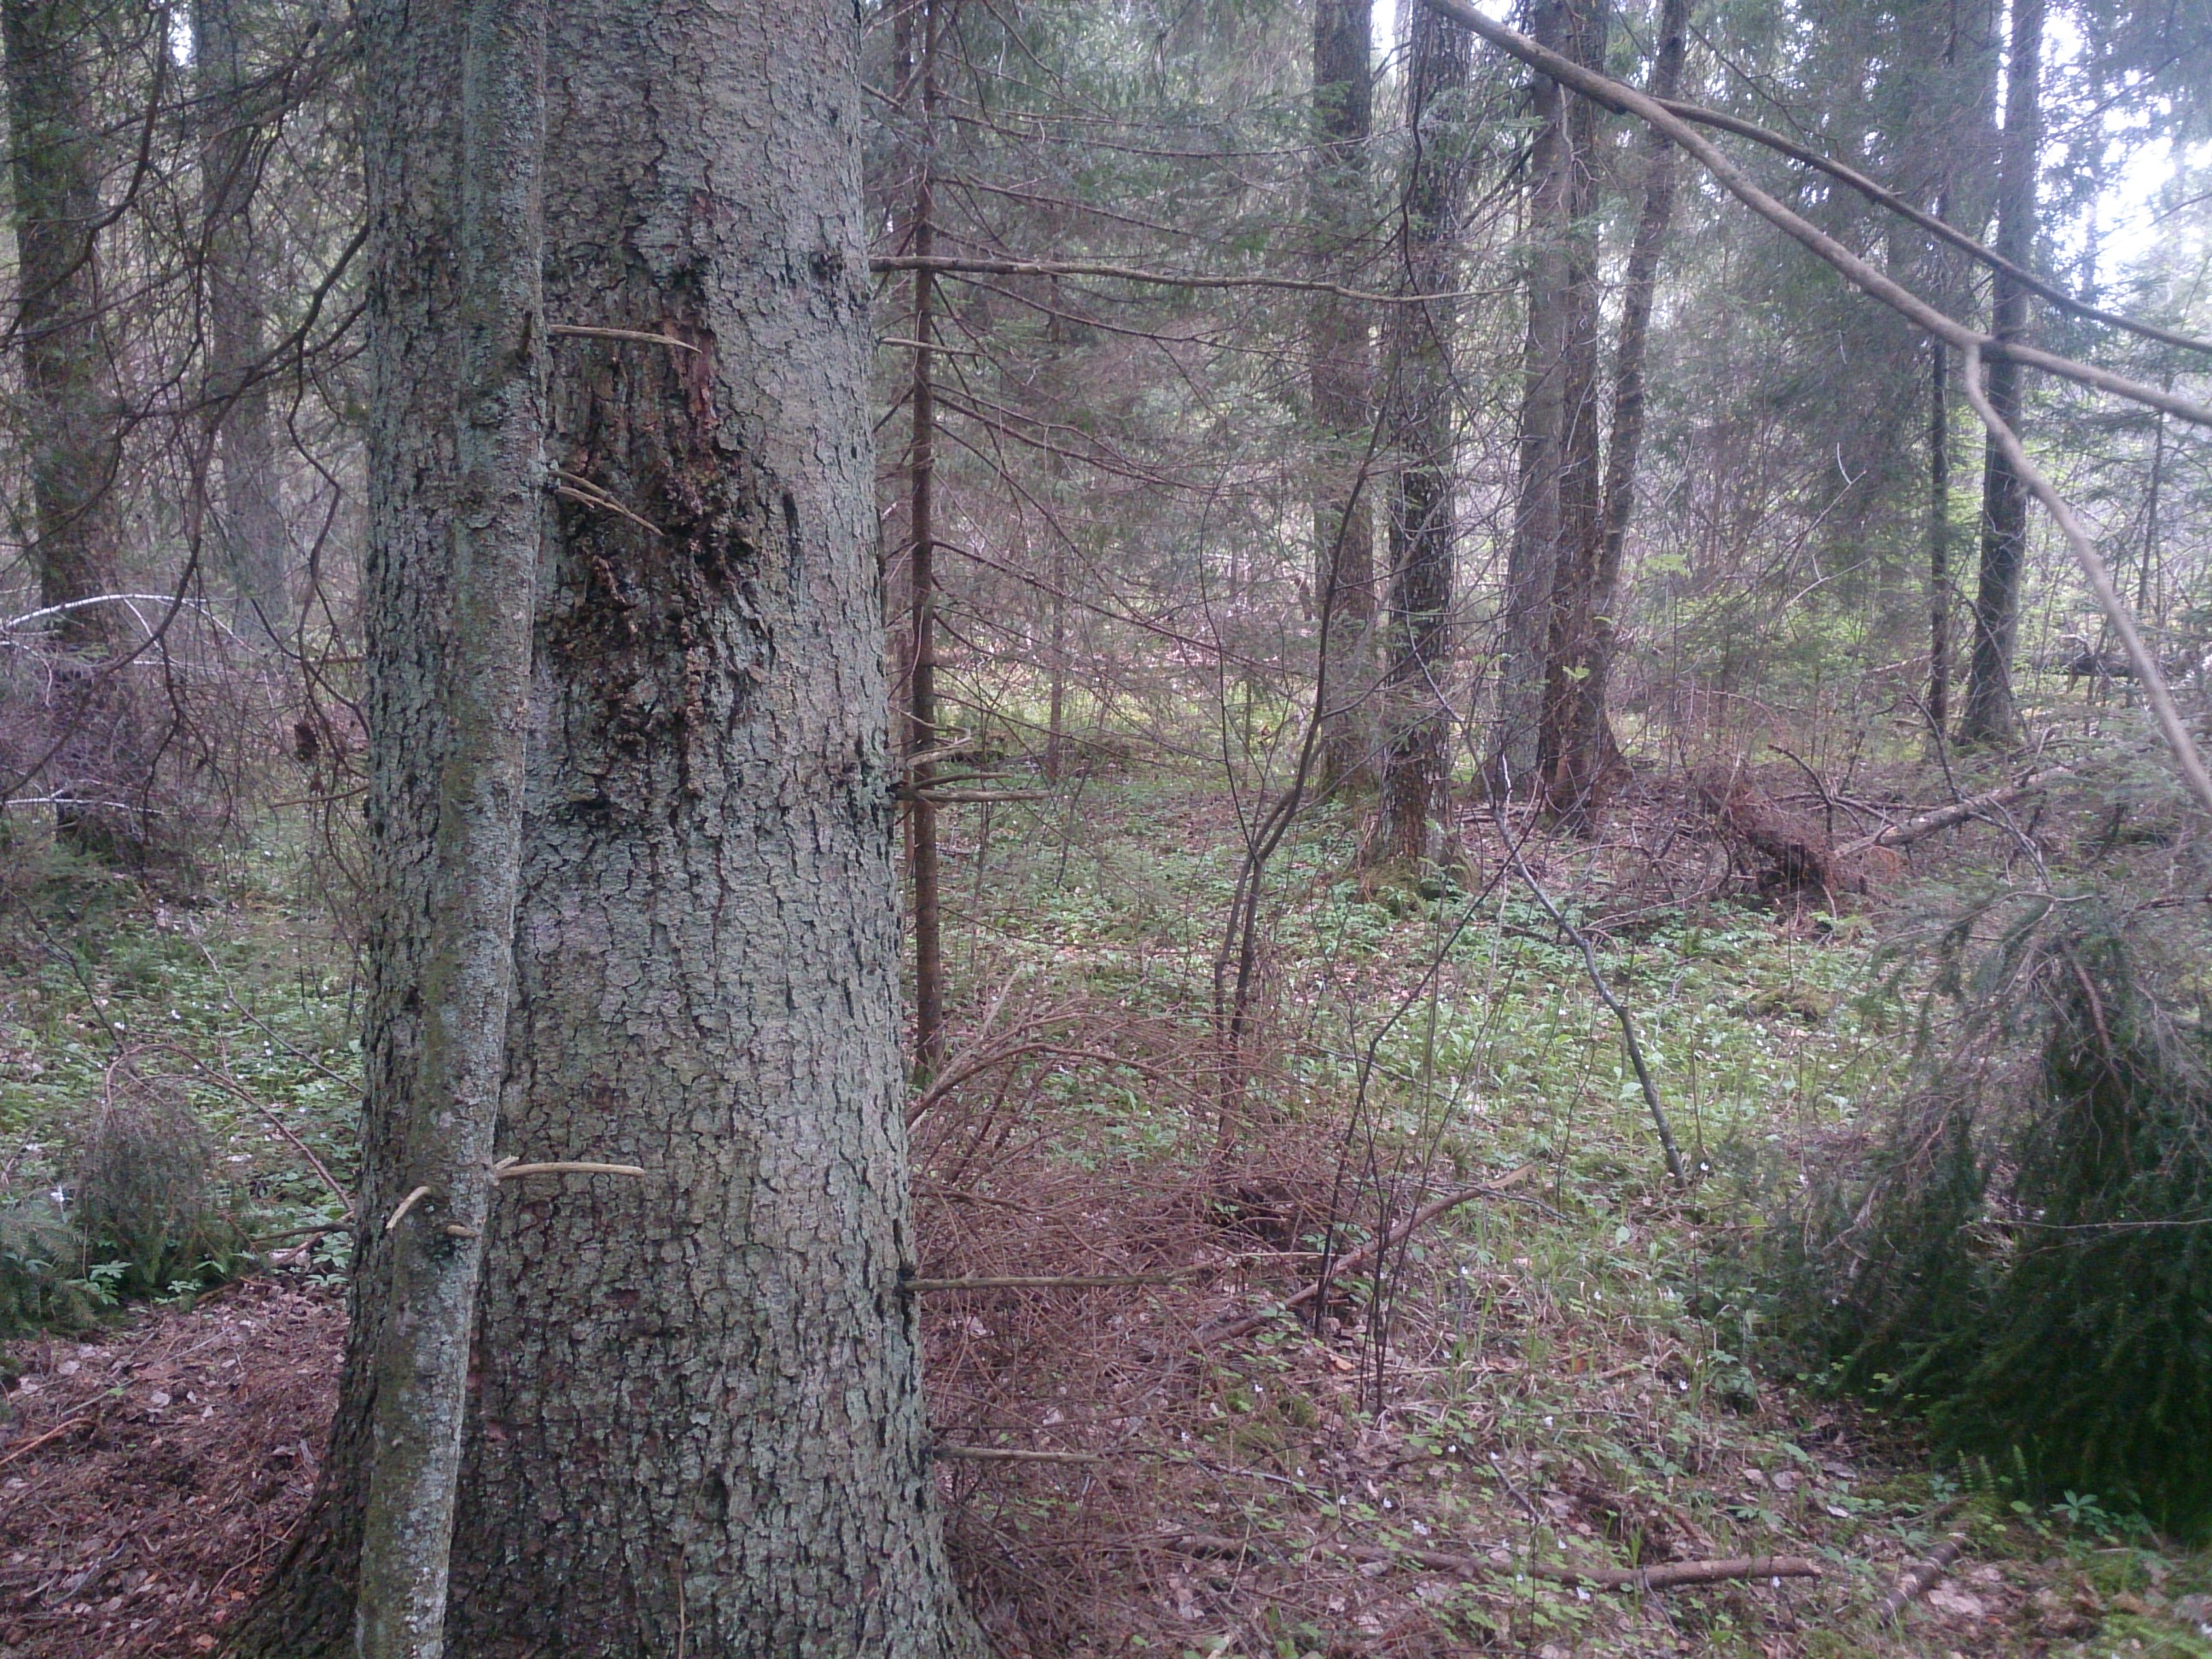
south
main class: Woodland
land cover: Other mixed woodland
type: hemiboreal forest and nemoral coniferous forest and mixed broadleaved-coniferous forest
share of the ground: > 75 %
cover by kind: coniferous forest trees 70 %, broadleaved forest trees 30 %
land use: Forestry
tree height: > 5 m
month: May
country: LV
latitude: 56.6935
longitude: 24.1797
